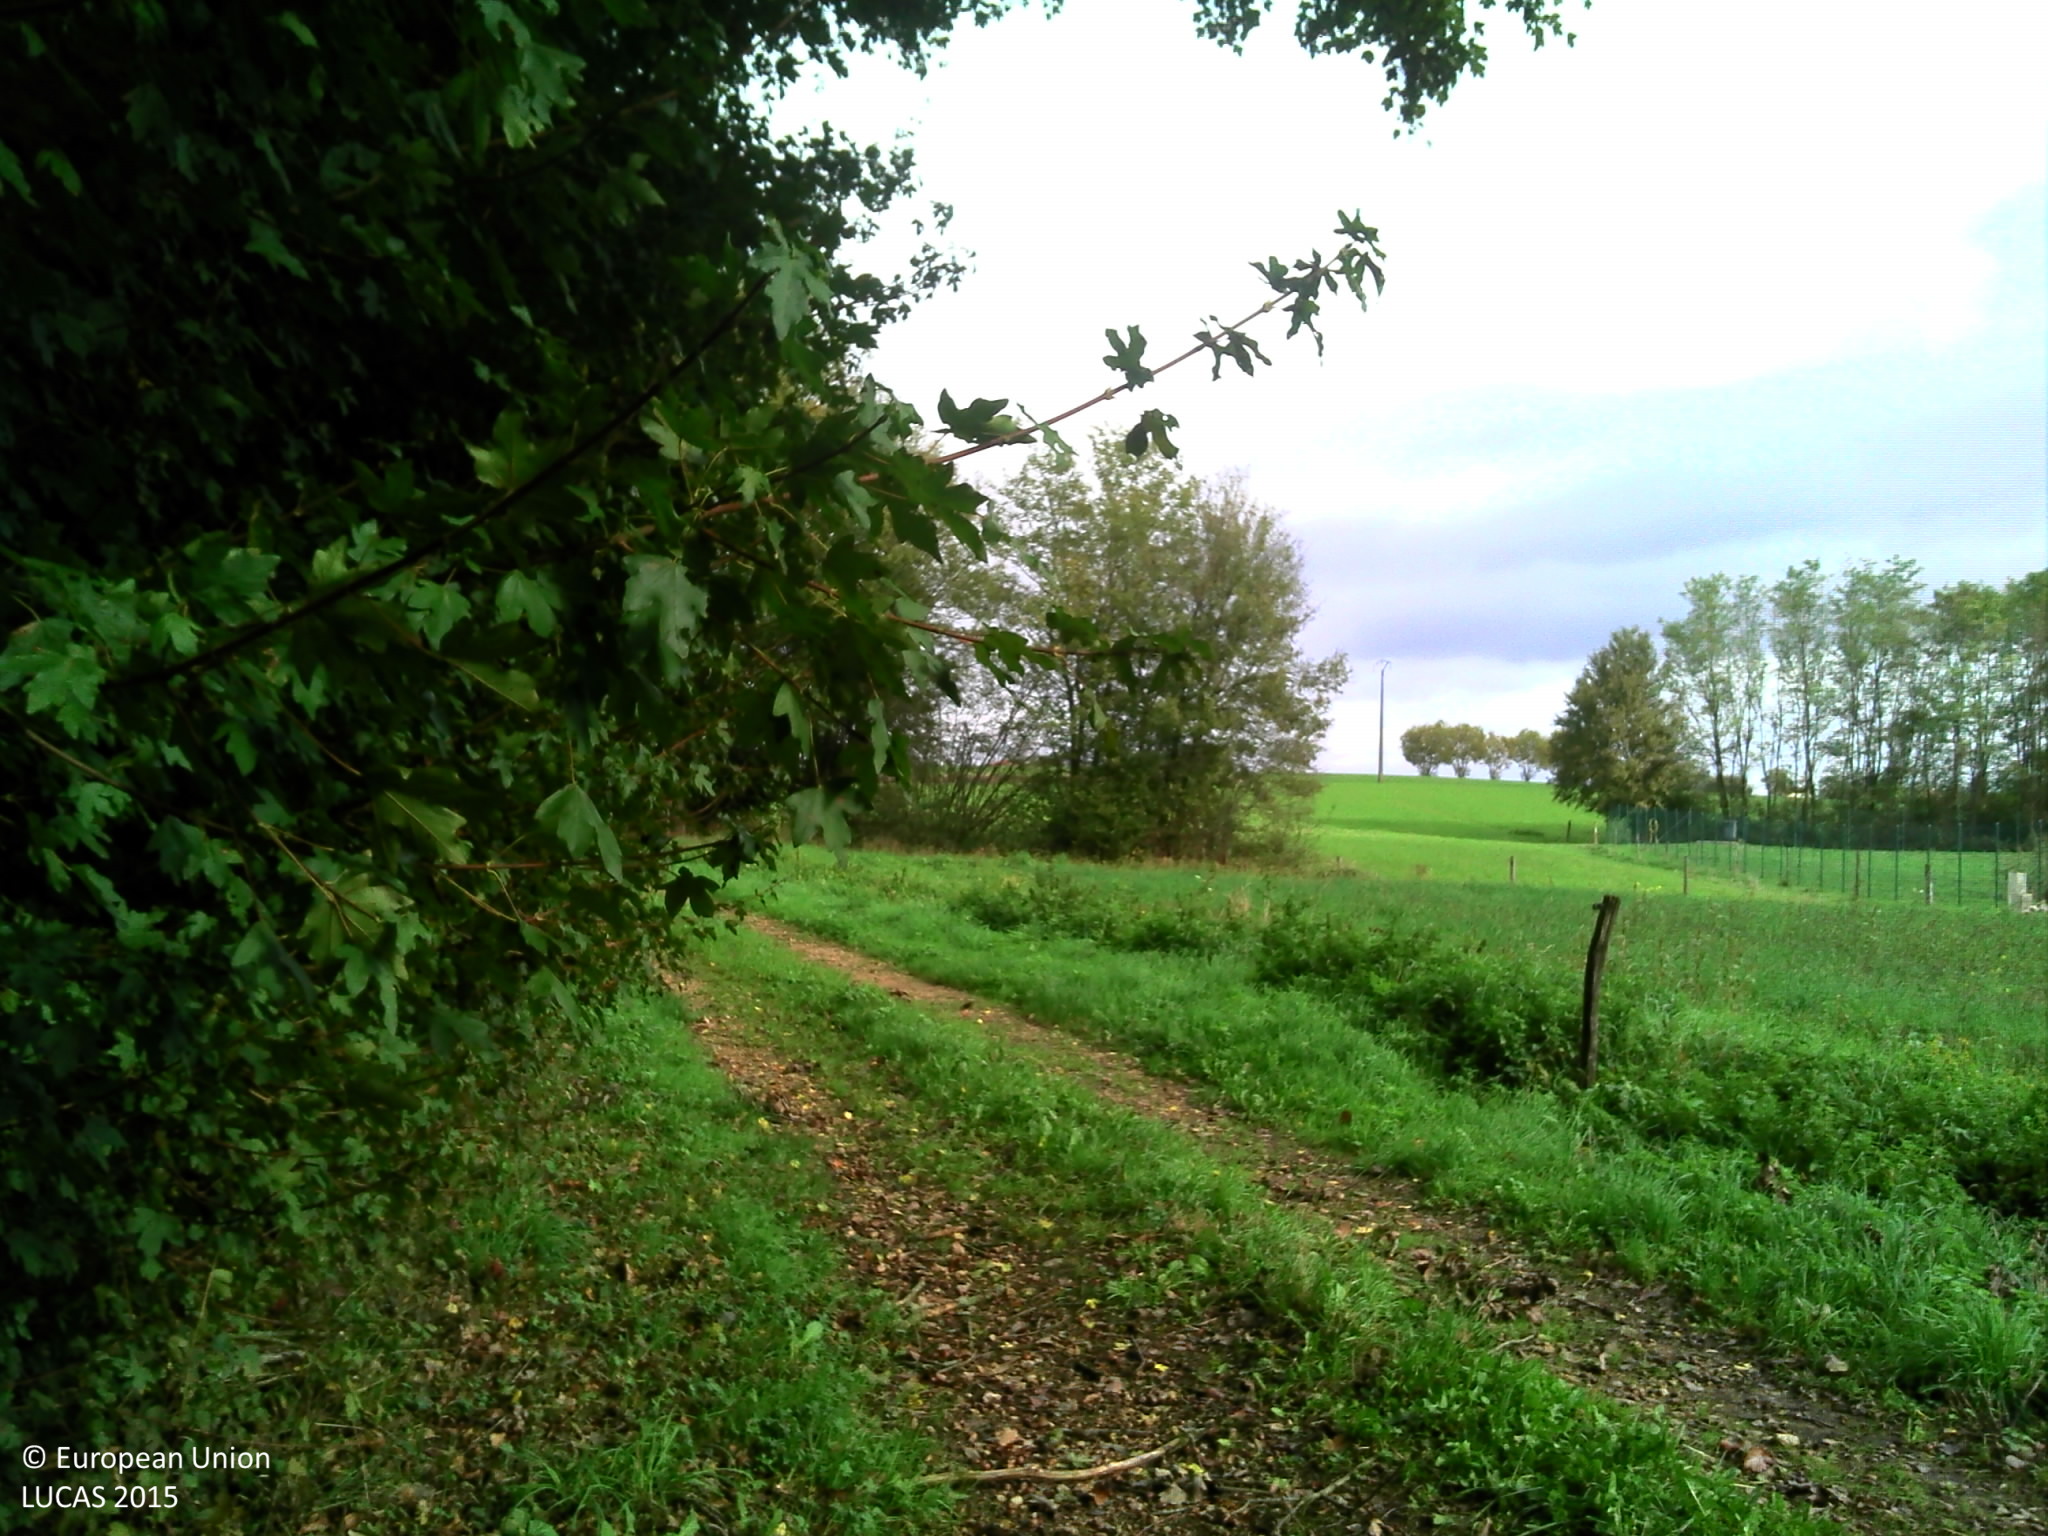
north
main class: Cropland
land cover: Common wheat
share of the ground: > 75 %
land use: Agriculture (excluding fallow land and kitchen gardens)
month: October
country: FR
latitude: 46.4540
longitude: 5.0680
